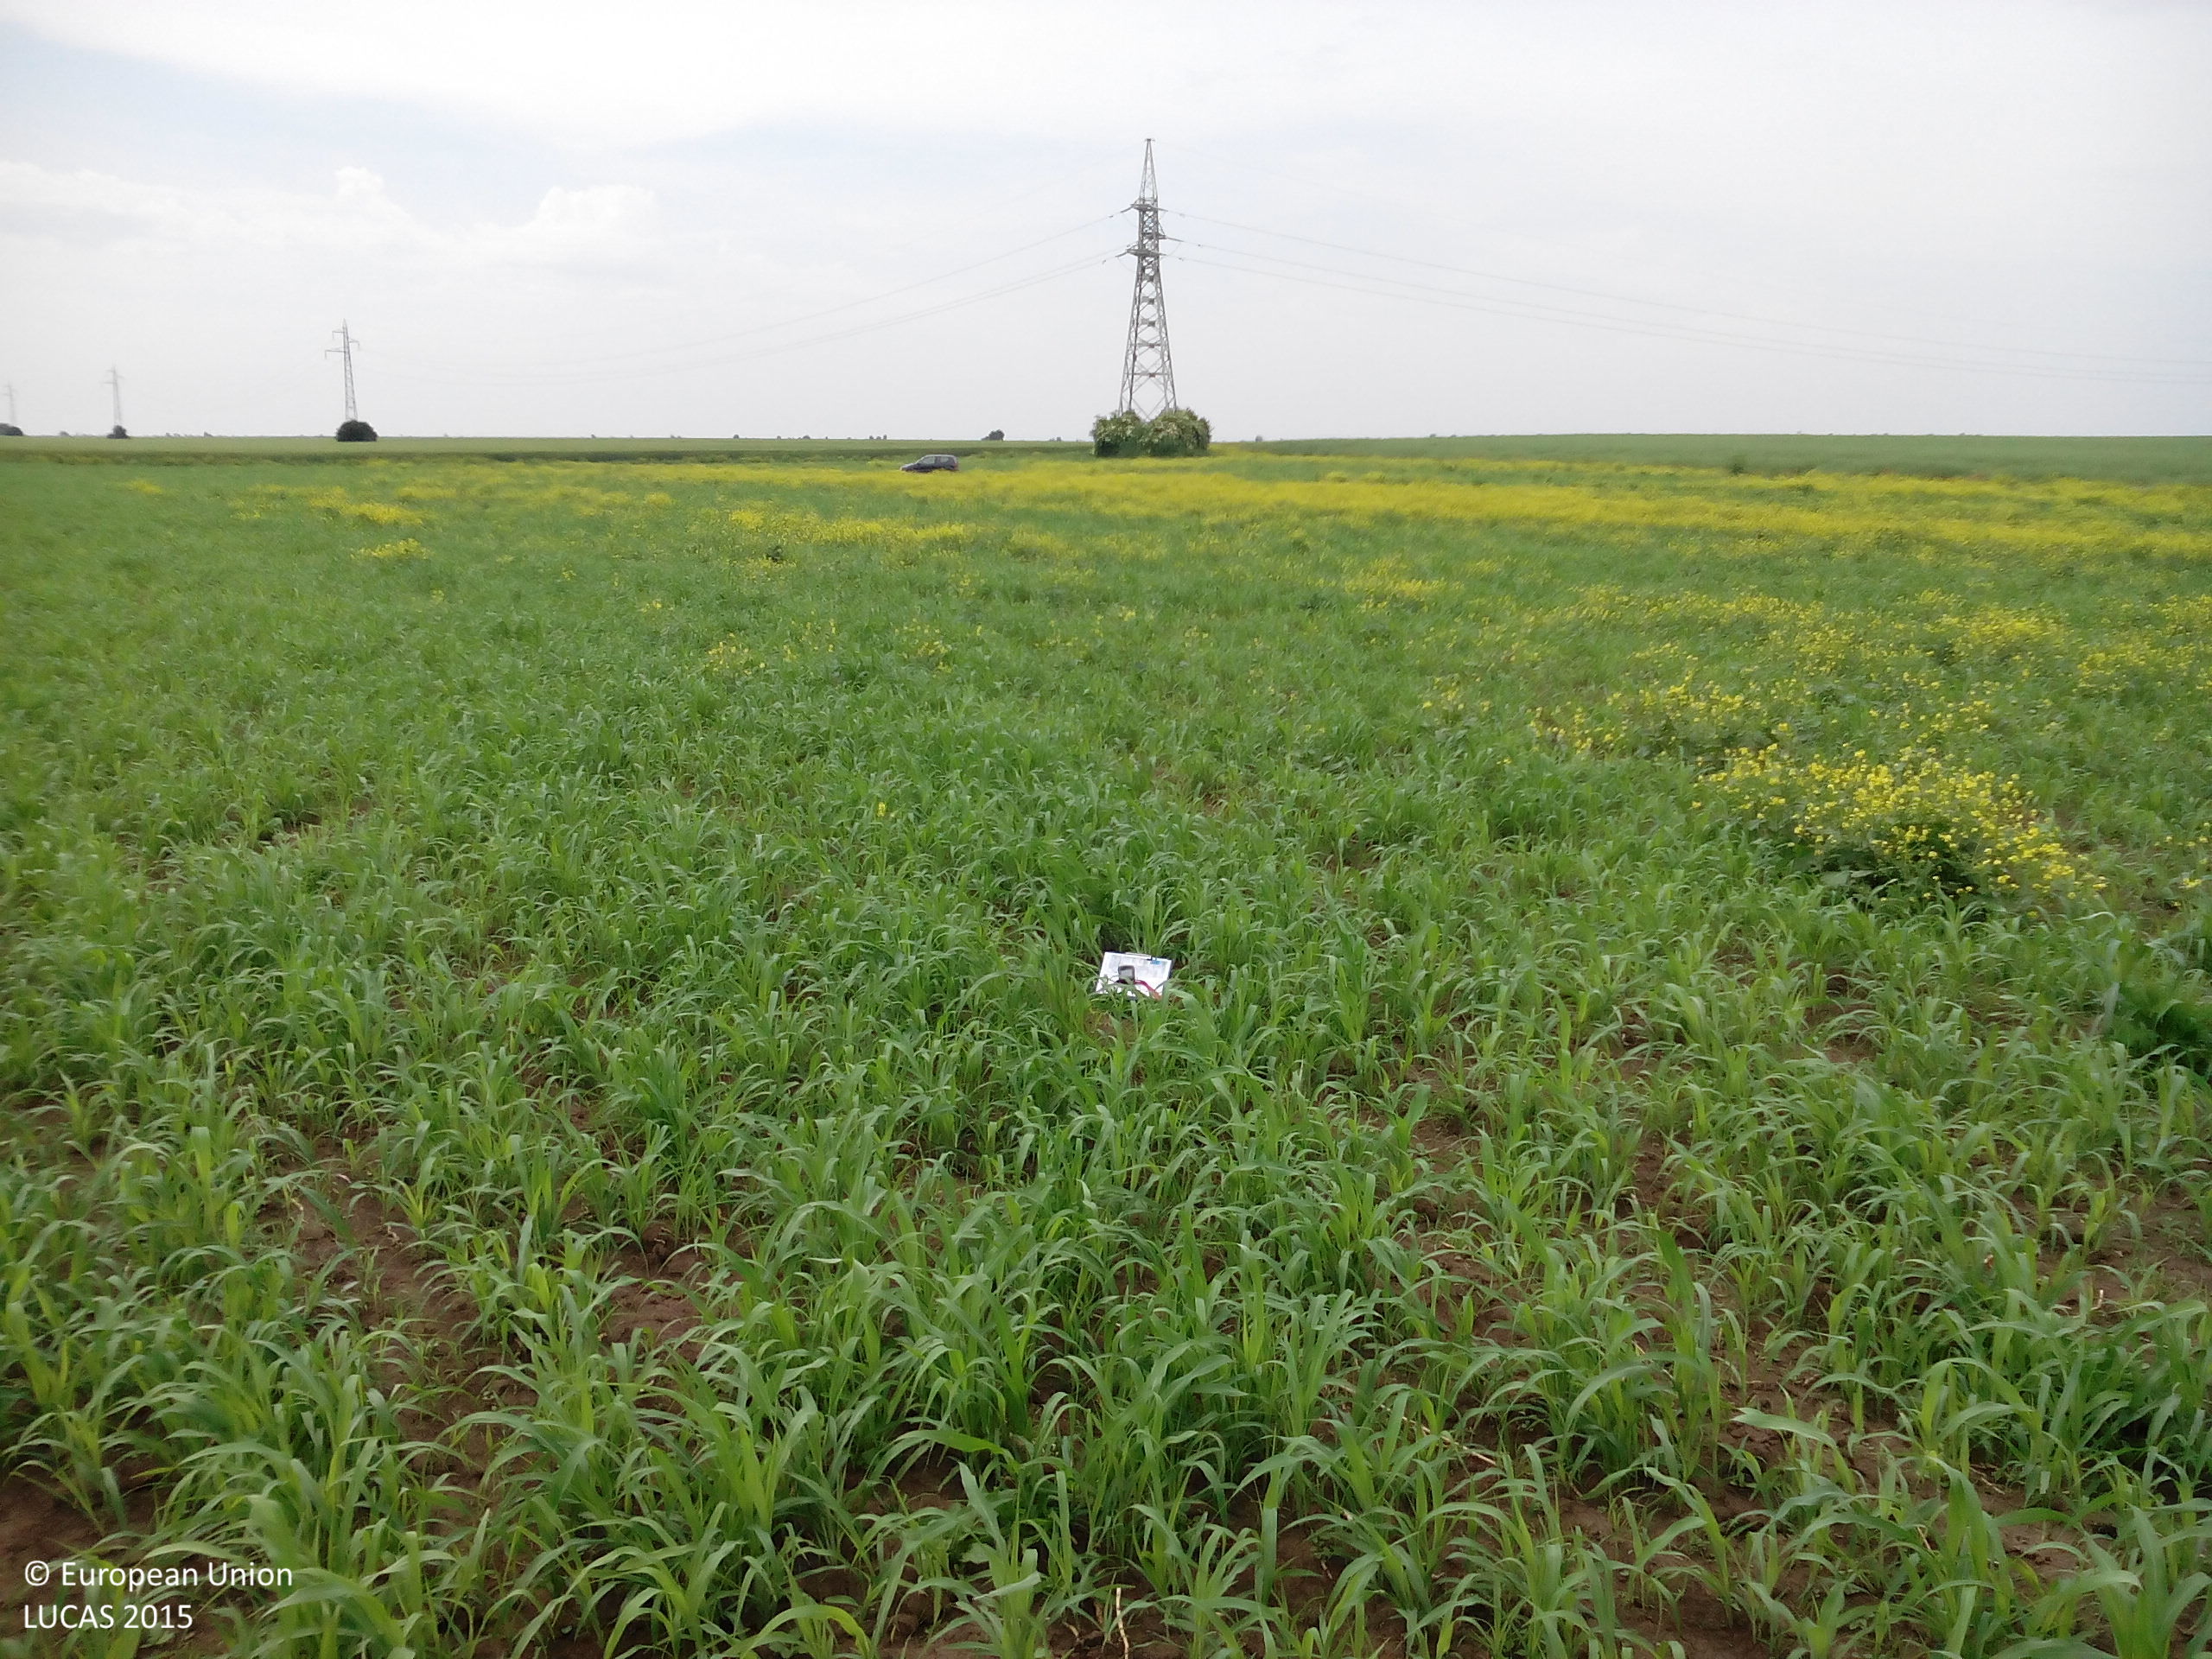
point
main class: Cropland
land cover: Common wheat
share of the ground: 50 - 75 %
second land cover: Rape and turnip rape
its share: 25 - 50 %
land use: Agriculture (excluding fallow land and kitchen gardens)
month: May
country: BG
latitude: 43.4735
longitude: 24.3618
